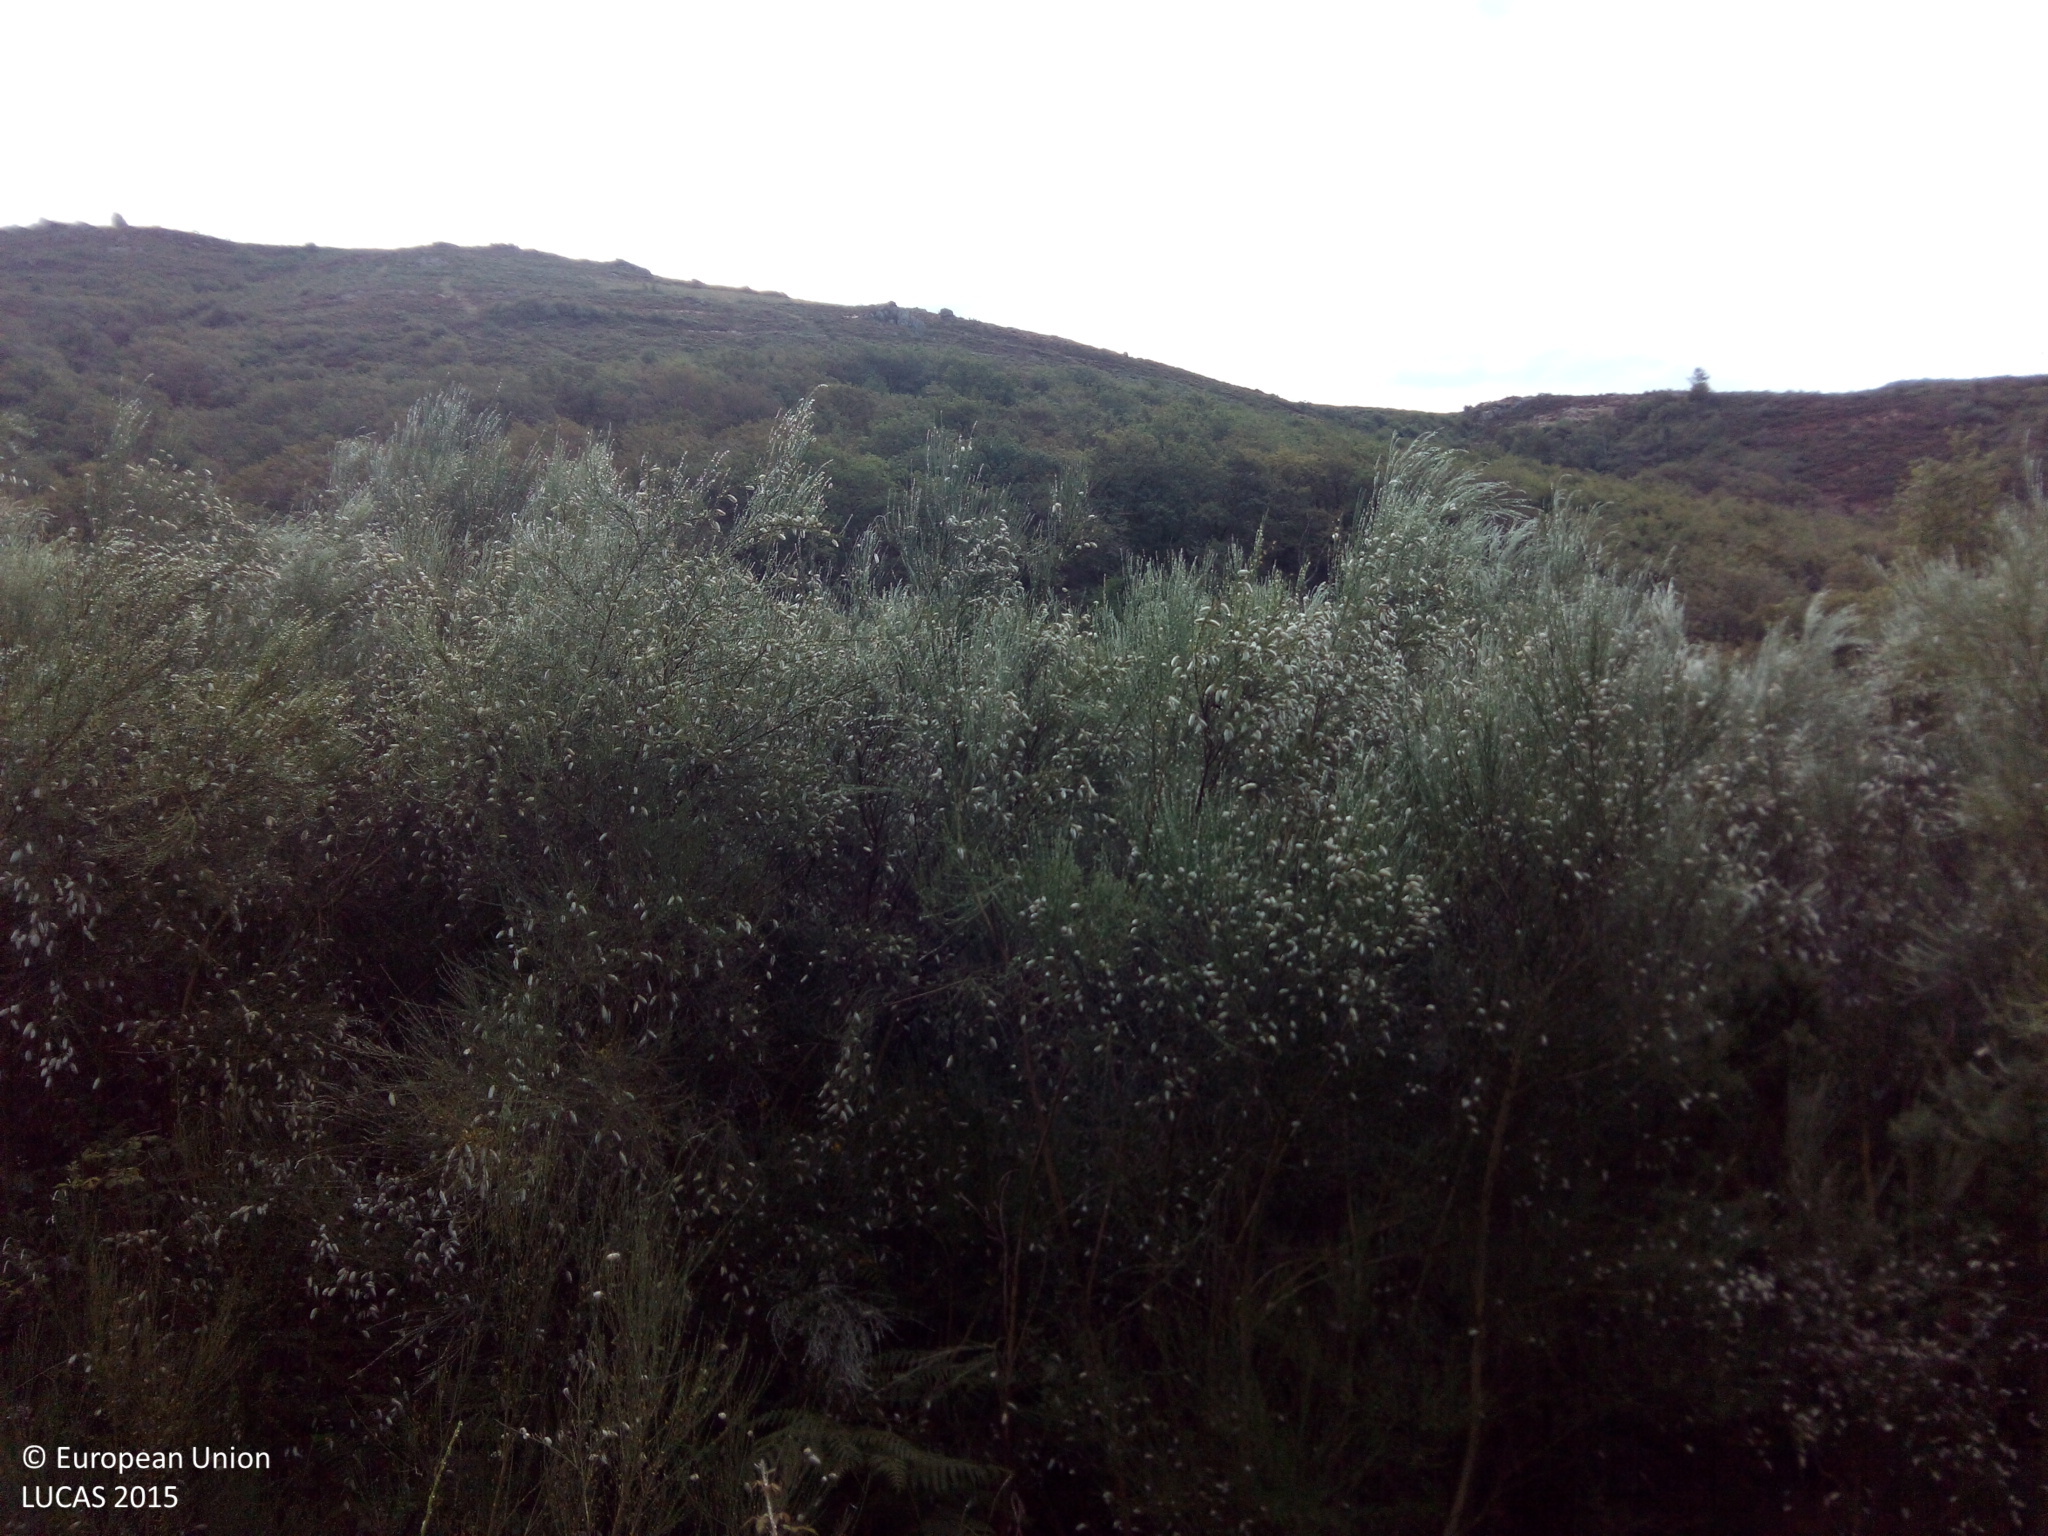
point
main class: Woodland
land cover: Broadleaved woodland
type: broadleaved evergreen forest
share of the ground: > 75 %
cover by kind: broadleaved forest trees 100 %
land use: Semi-natural and natural areas not in use
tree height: > 5 m
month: July
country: ES
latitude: 42.3004
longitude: -8.2963
